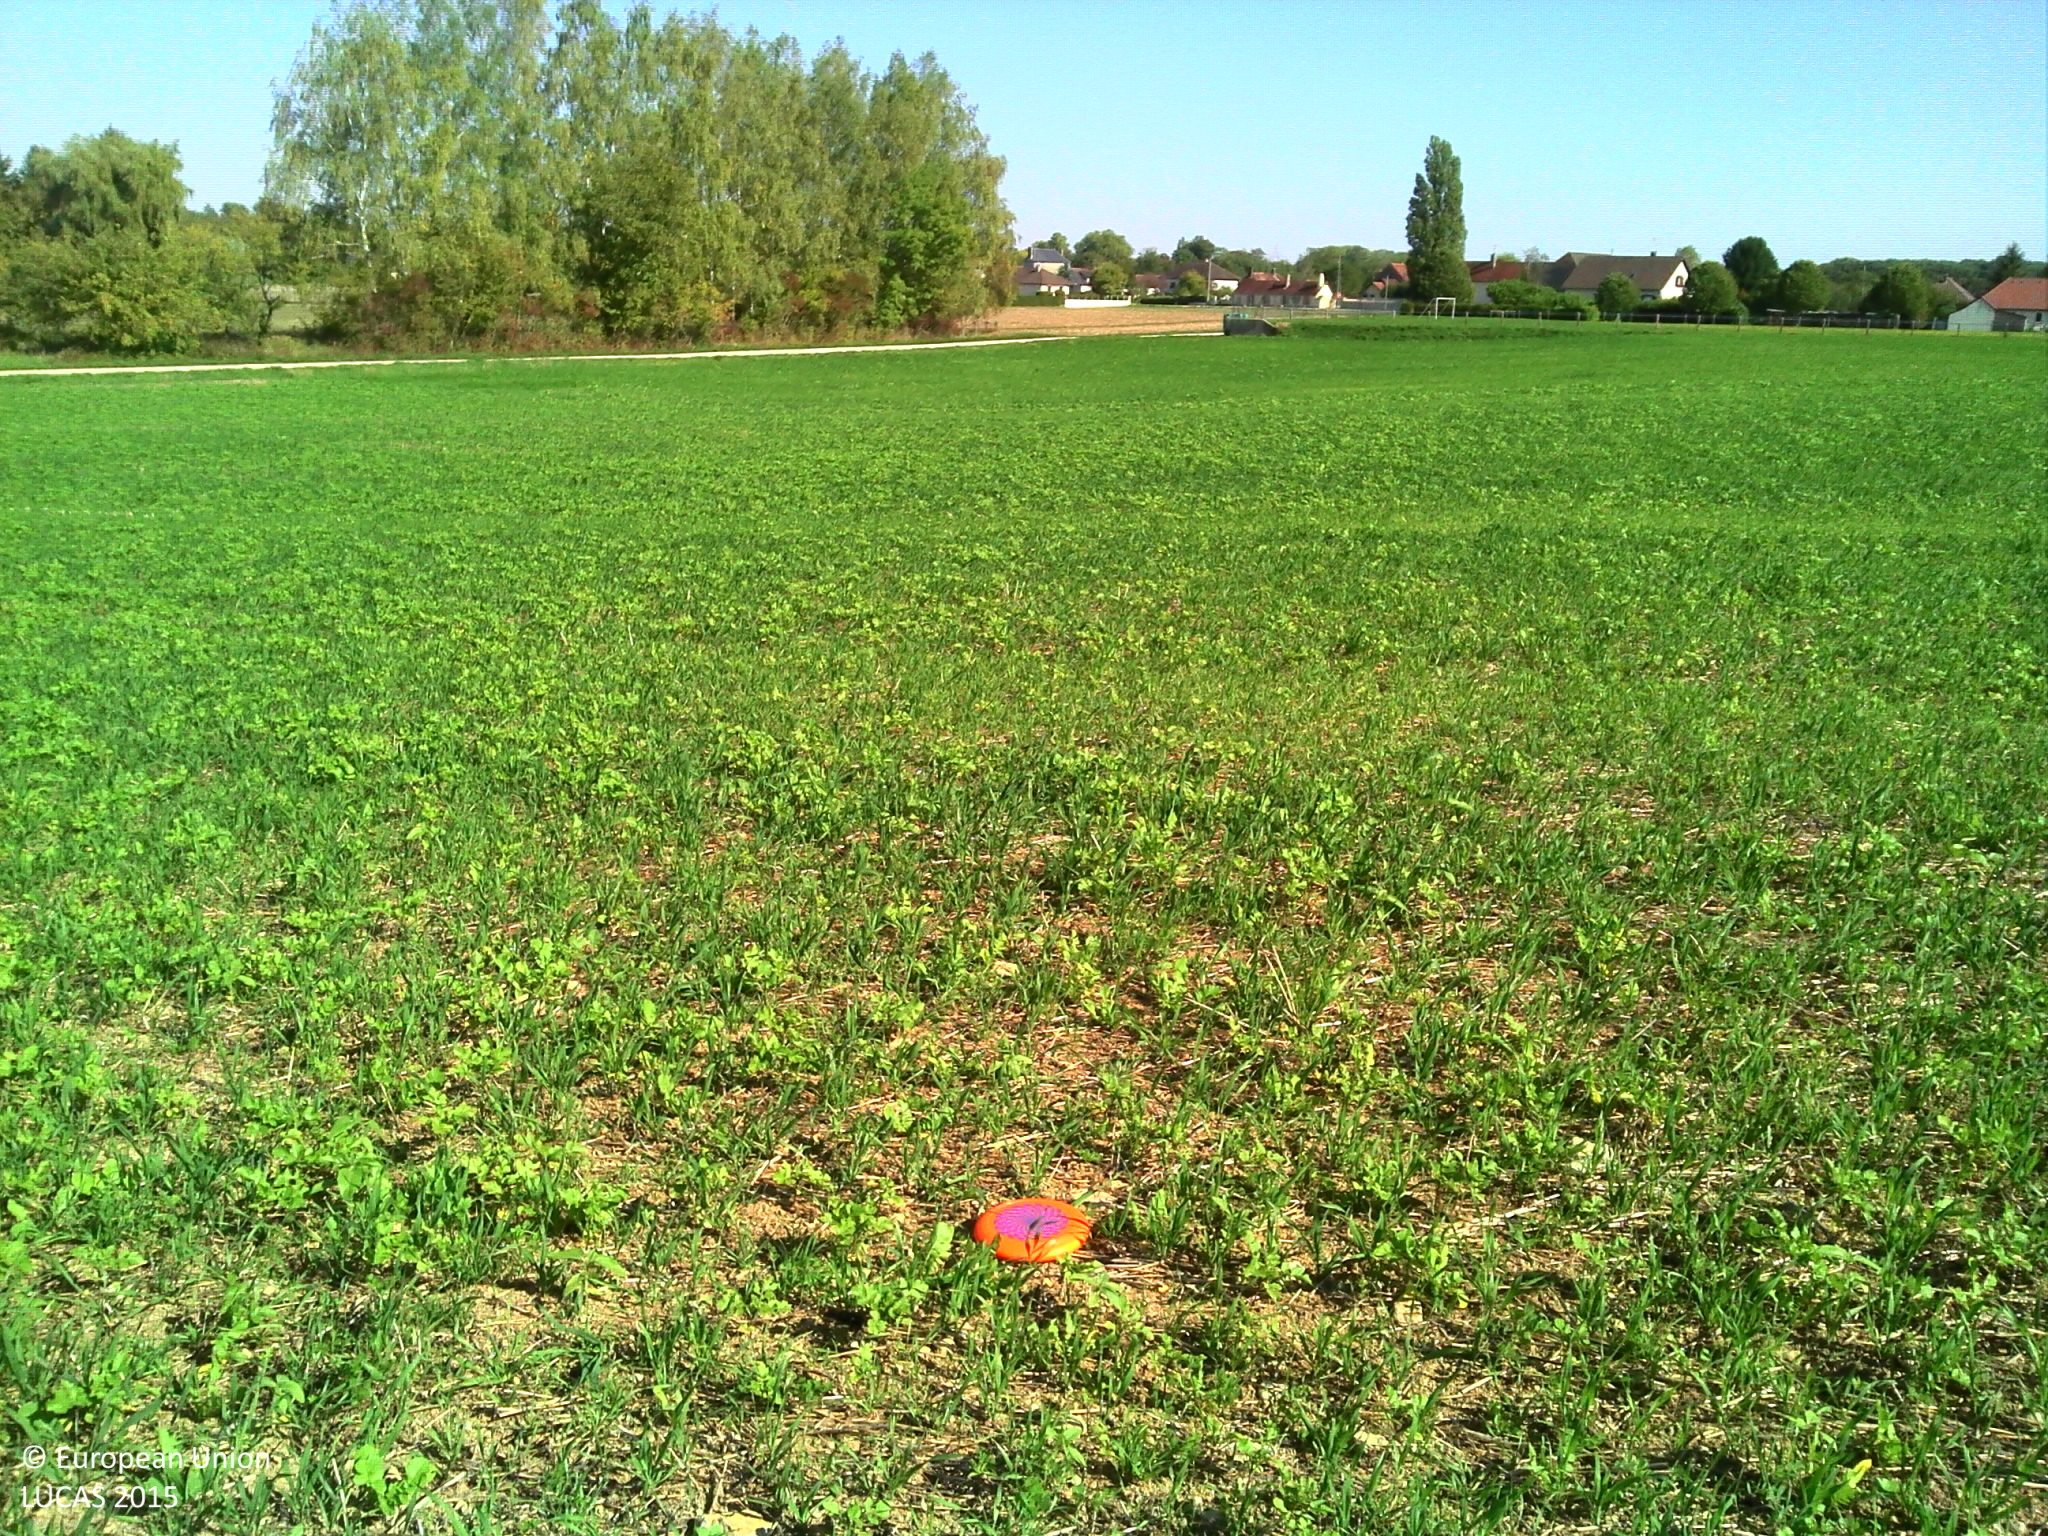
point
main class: Cropland
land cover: Other fibre and oleaginous crops
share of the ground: 50 - 75 %
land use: Agriculture (excluding fallow land and kitchen gardens)
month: September
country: FR
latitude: 48.1461
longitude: 4.2581
